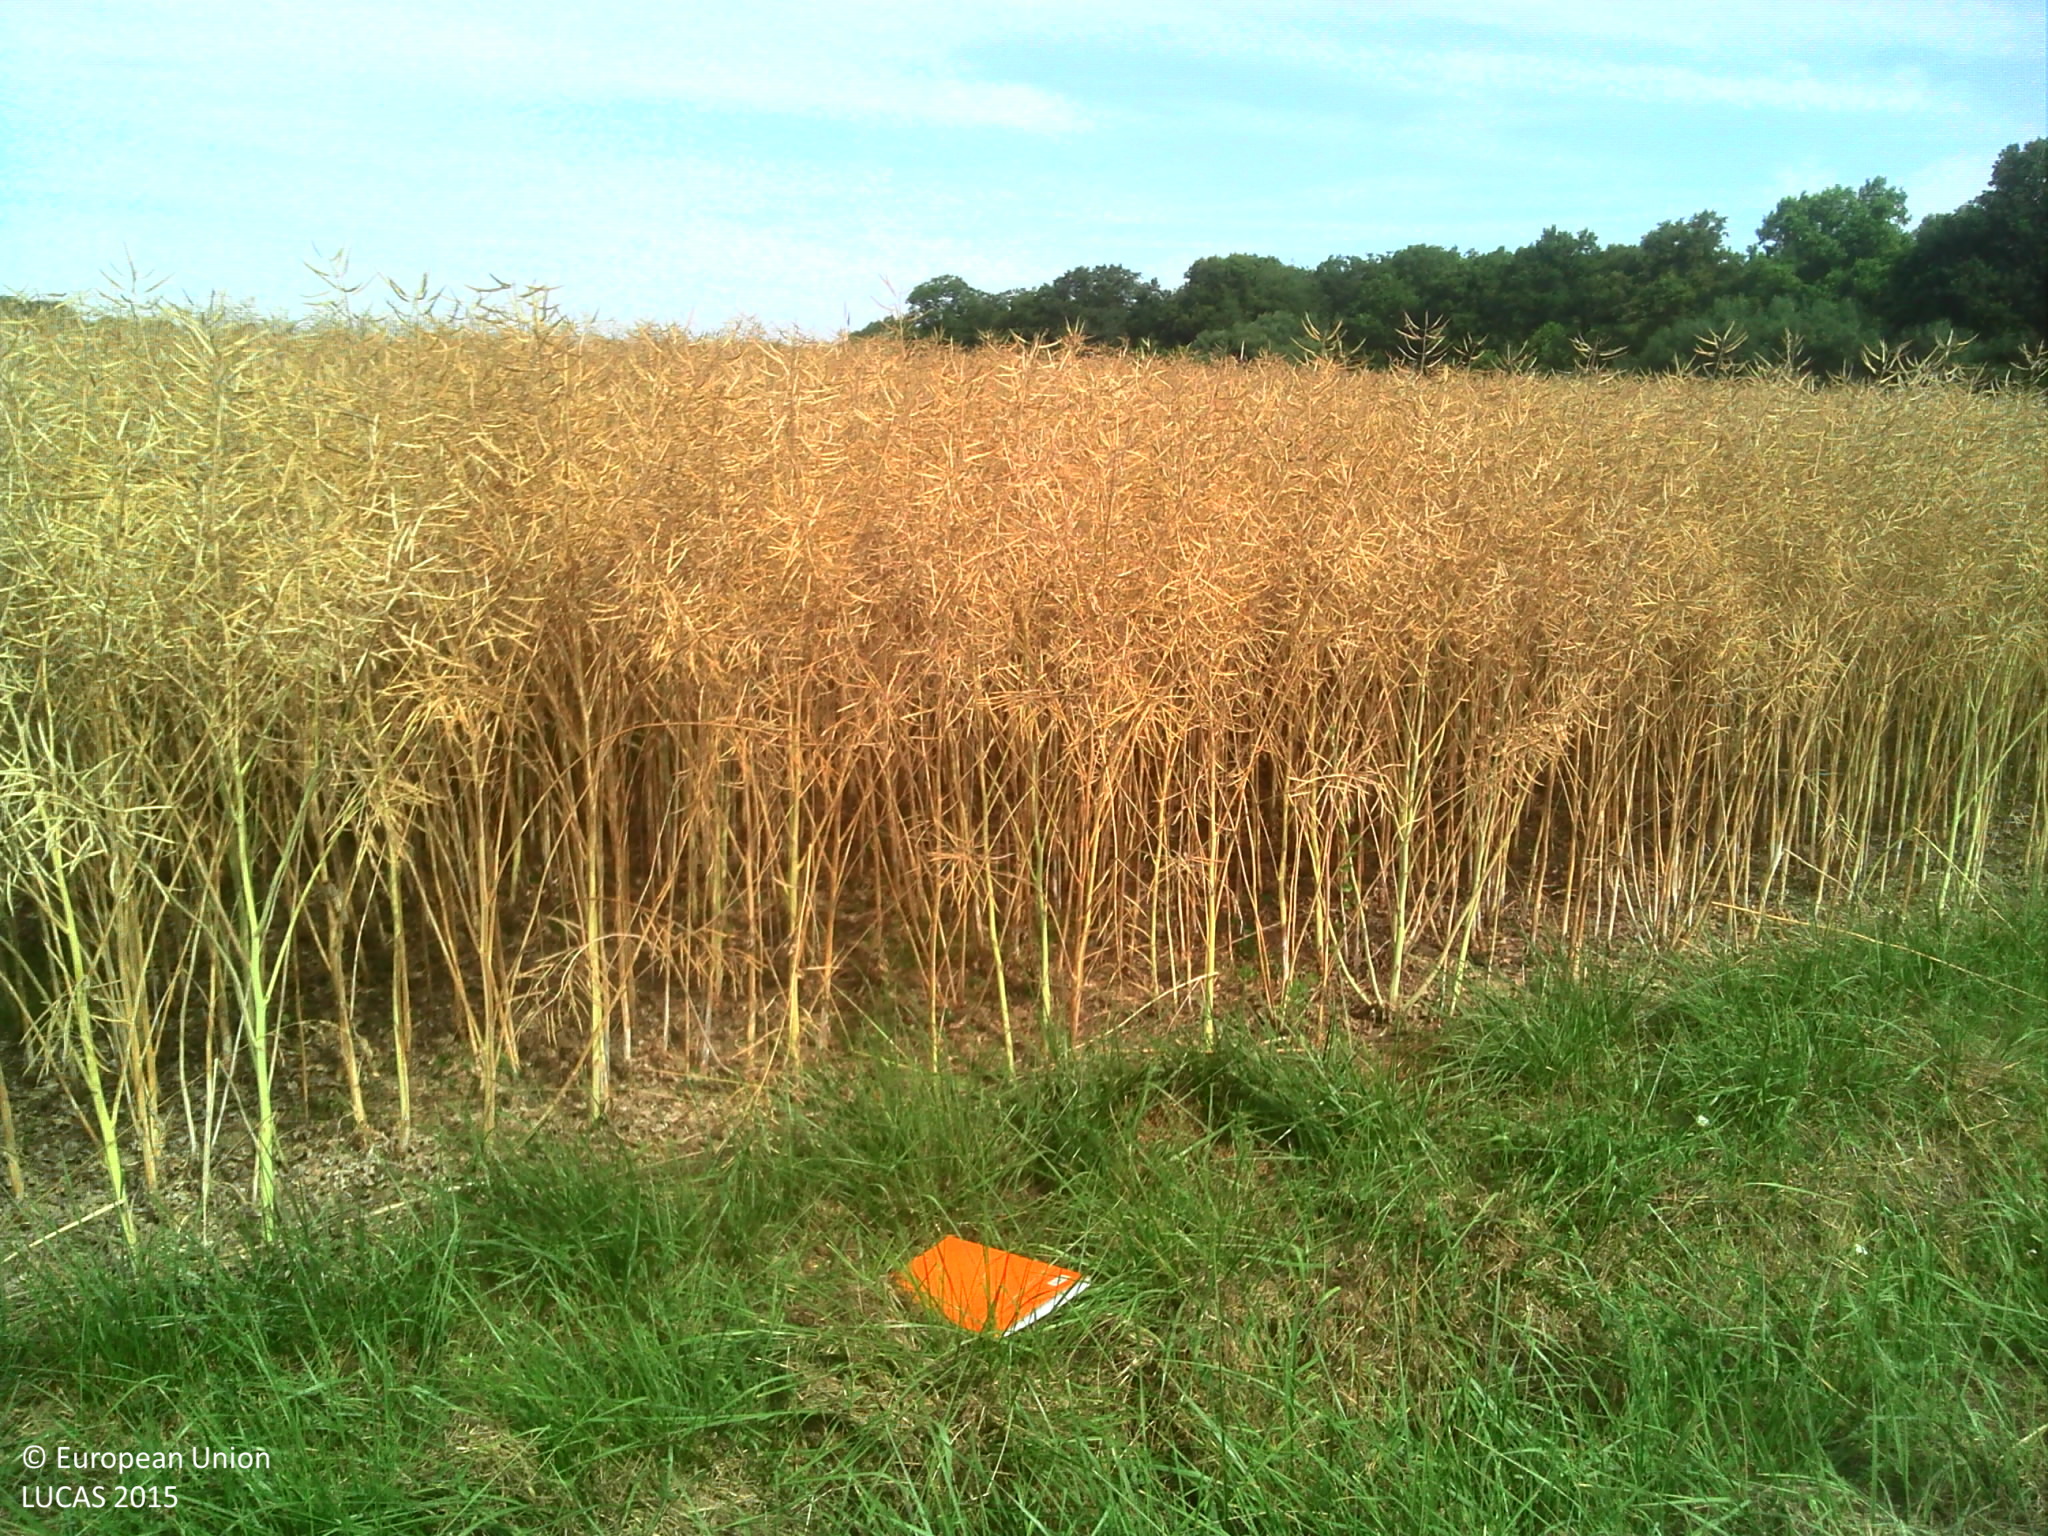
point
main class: Cropland
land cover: Rape and turnip rape
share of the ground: > 75 %
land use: Agriculture (excluding fallow land and kitchen gardens)
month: June
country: FR
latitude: 46.7111
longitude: 4.7820
